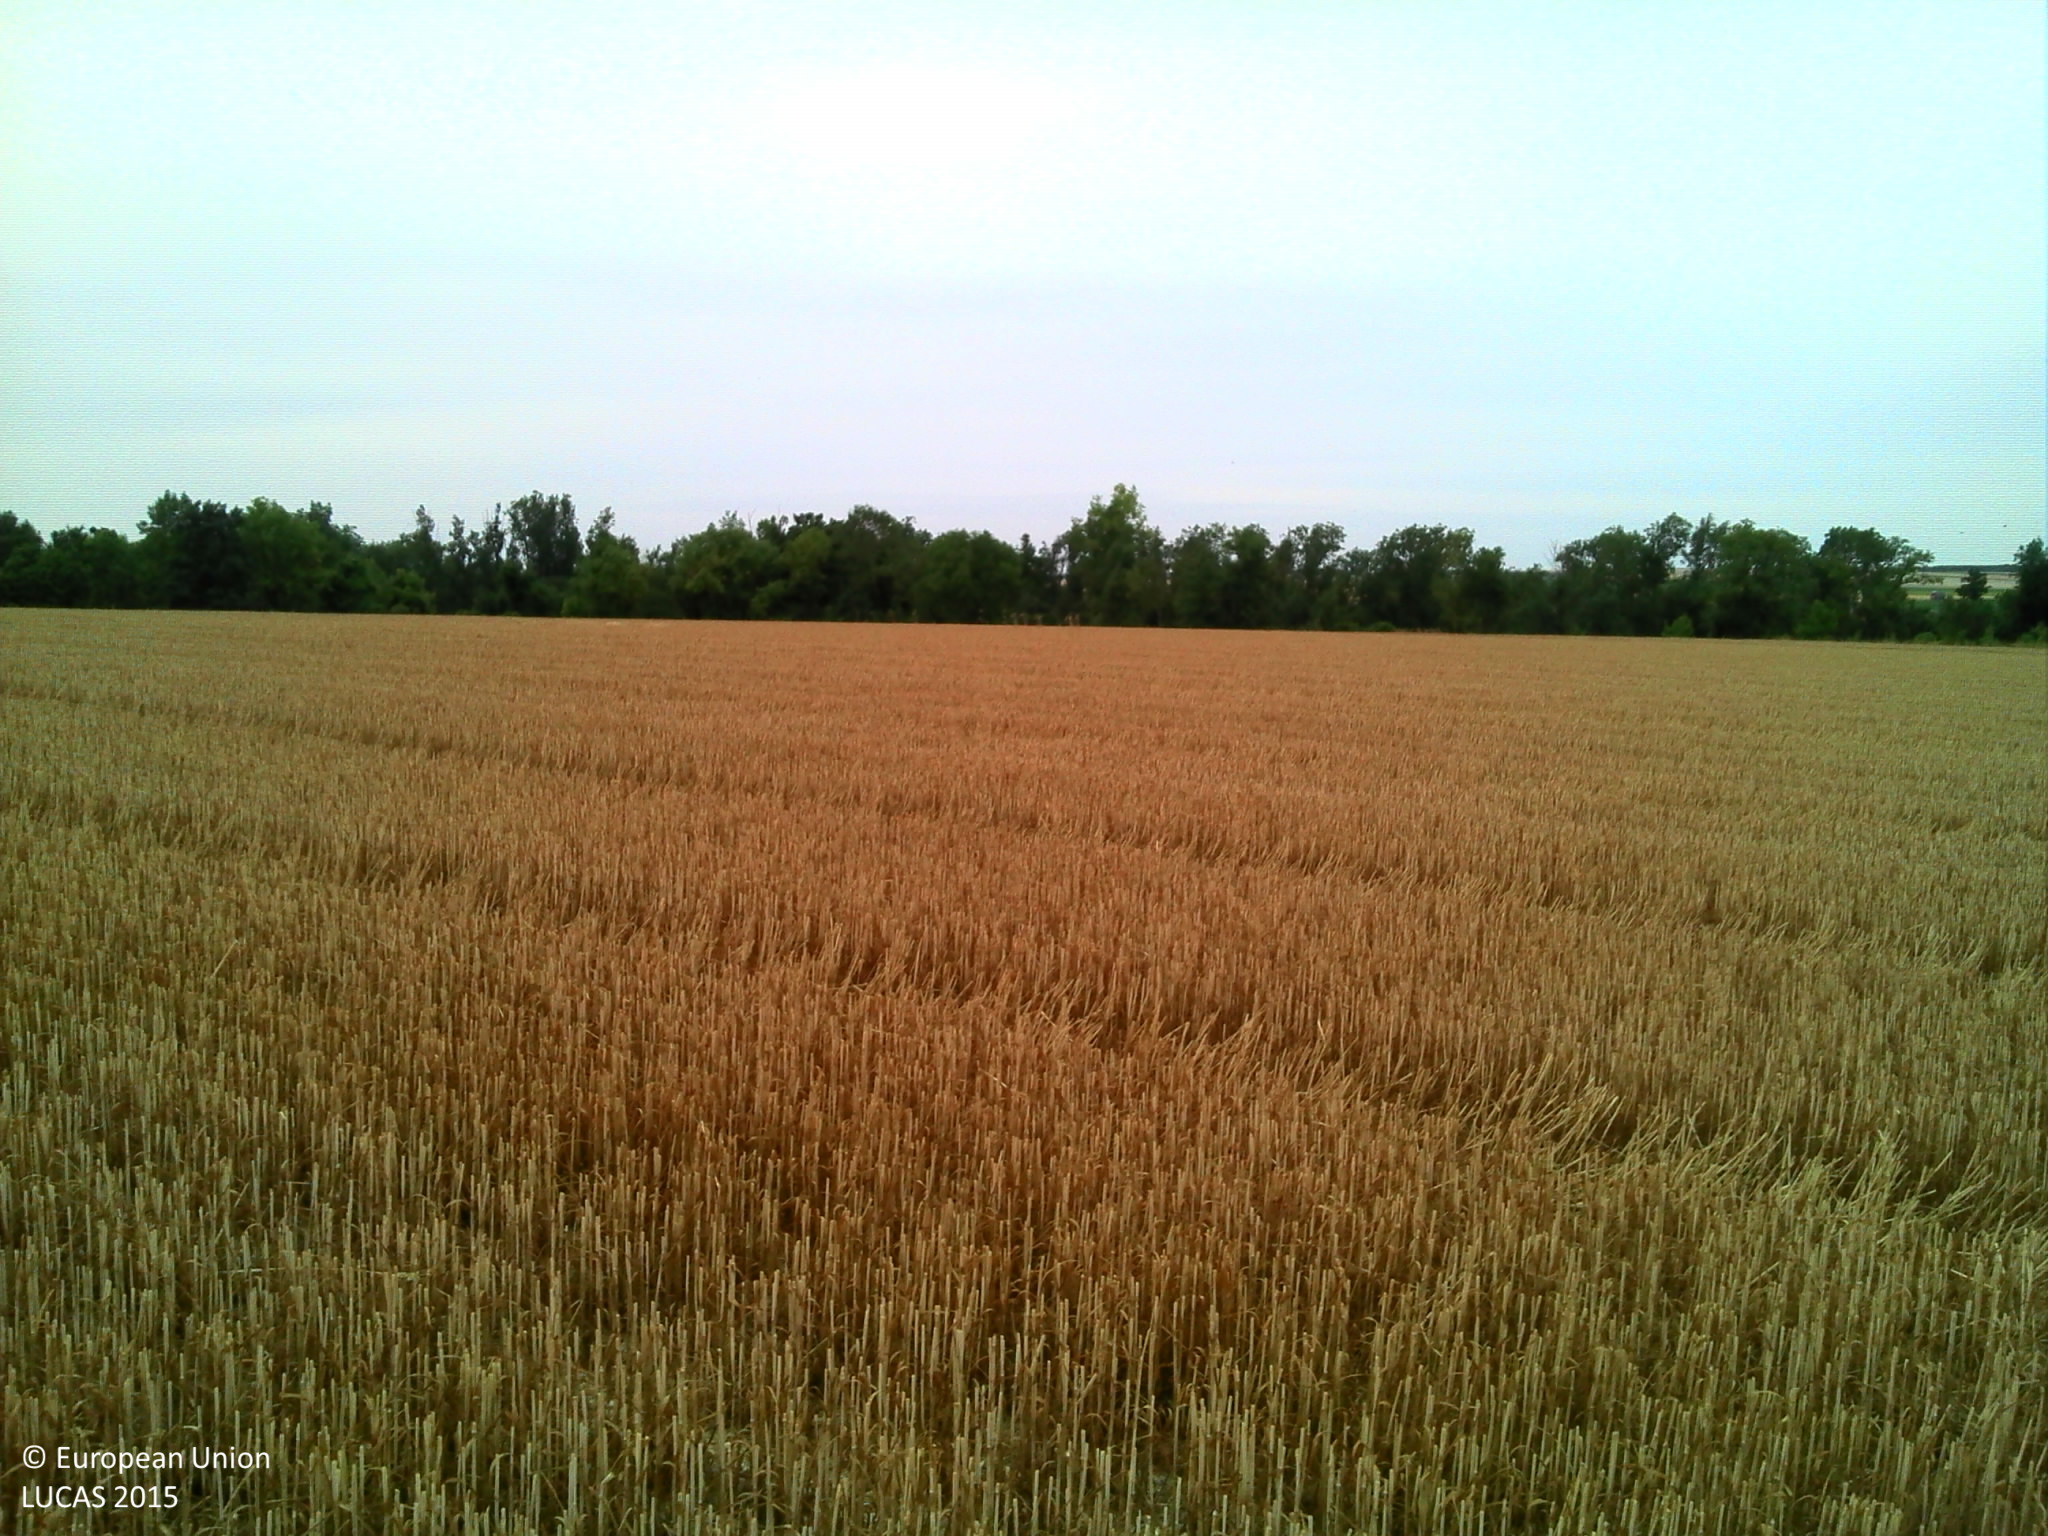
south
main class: Cropland
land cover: Common wheat
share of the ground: > 75 %
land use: Agriculture (excluding fallow land and kitchen gardens)
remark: Harvested field
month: July
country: FR
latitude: 48.8632
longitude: 4.1752
